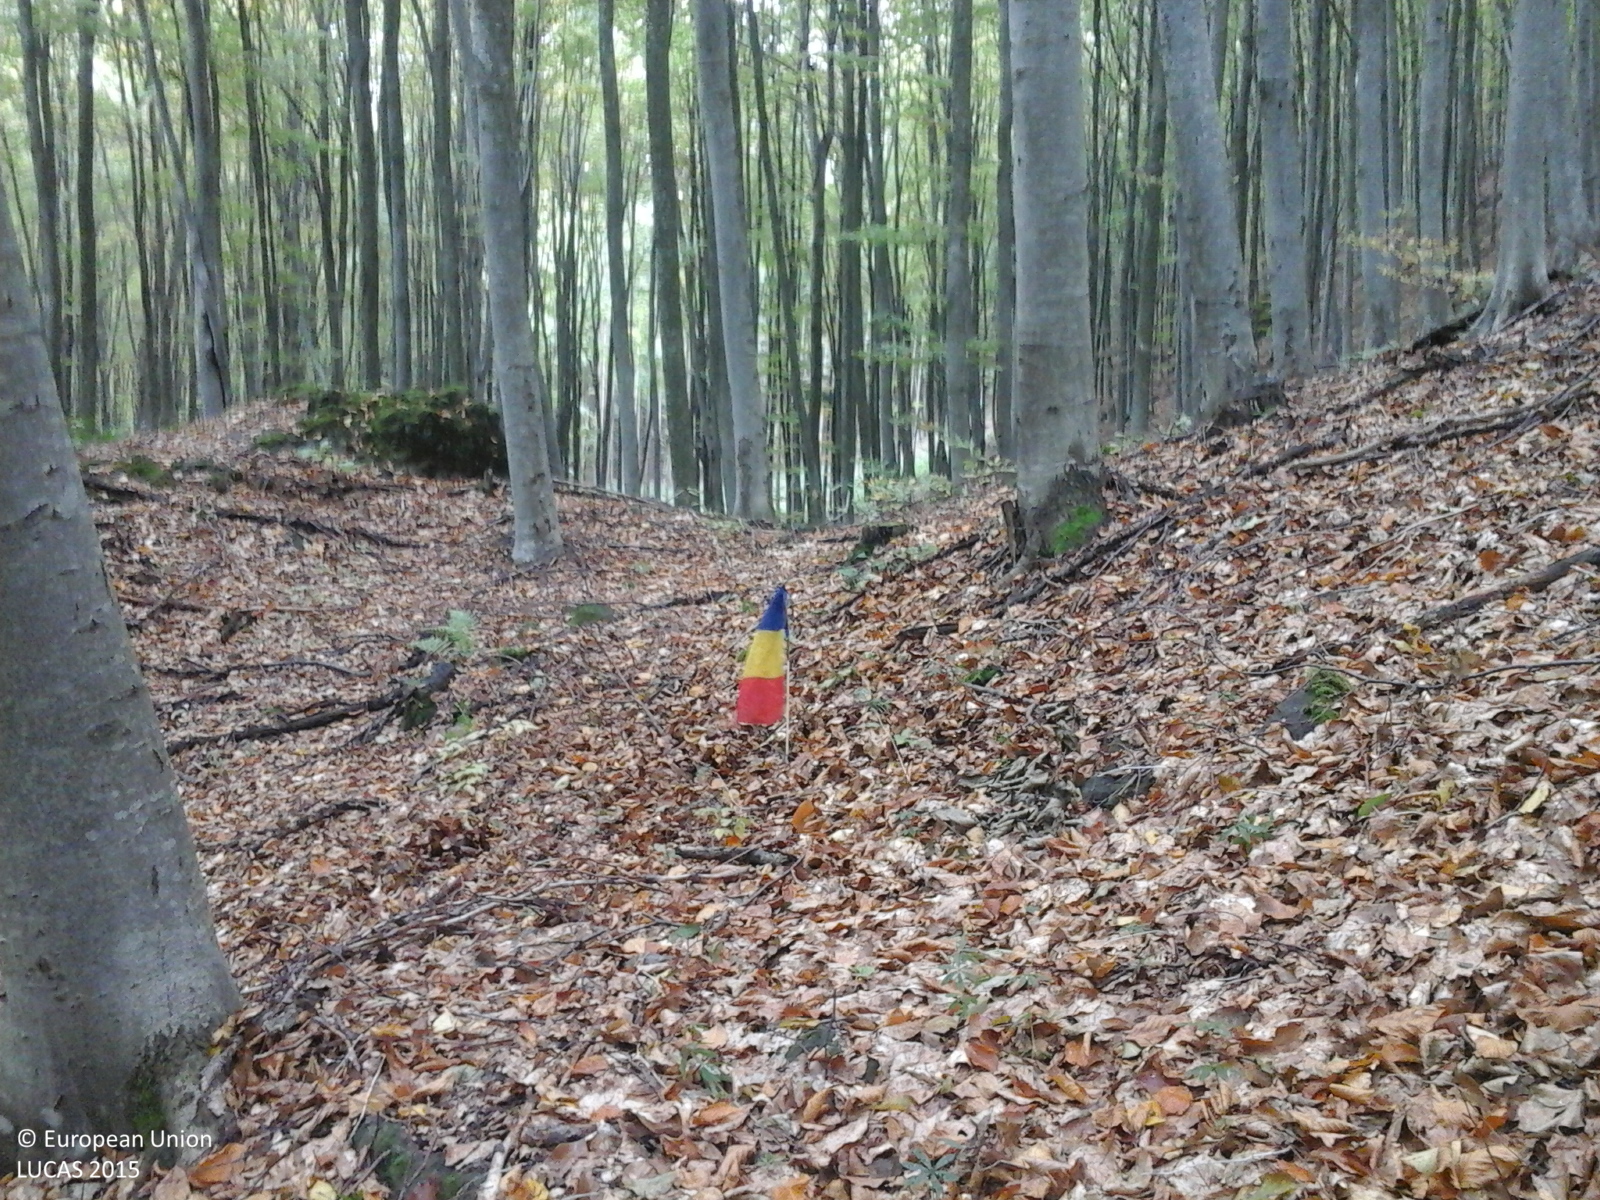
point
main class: Woodland
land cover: Broadleaved woodland
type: beech forest
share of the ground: > 75 %
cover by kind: broadleaved forest trees 100 %
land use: Forestry
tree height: > 5 m
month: October
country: RO
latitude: 46.6436
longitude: 24.9786
